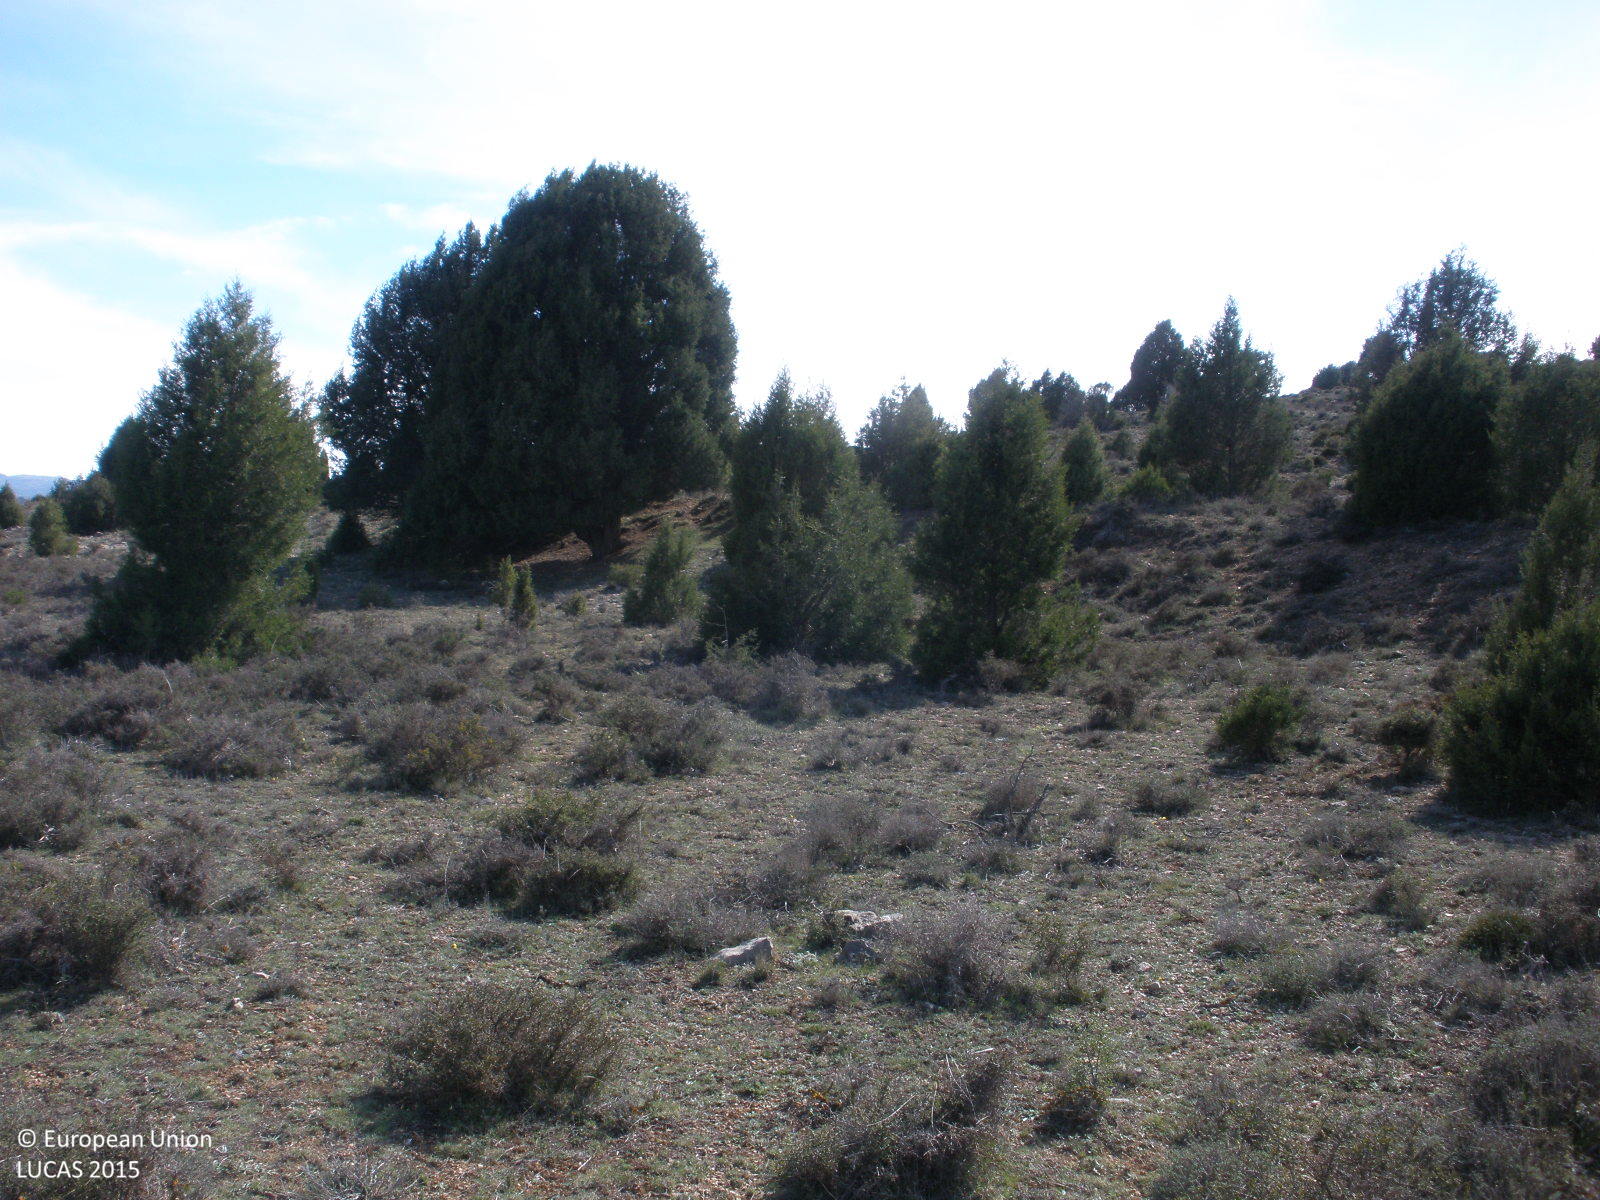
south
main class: Shrubland
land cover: Shrubland with sparse tree cover
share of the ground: 25 - 50 %
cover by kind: shrubs 40 %, consolidated bare surface 30 %, herbaceous plants 25 %, coniferous forest trees 5 %
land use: Agriculture (excluding fallow land and kitchen gardens)
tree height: < 5 m
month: April
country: ES
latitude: 40.2514
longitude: -0.9776
